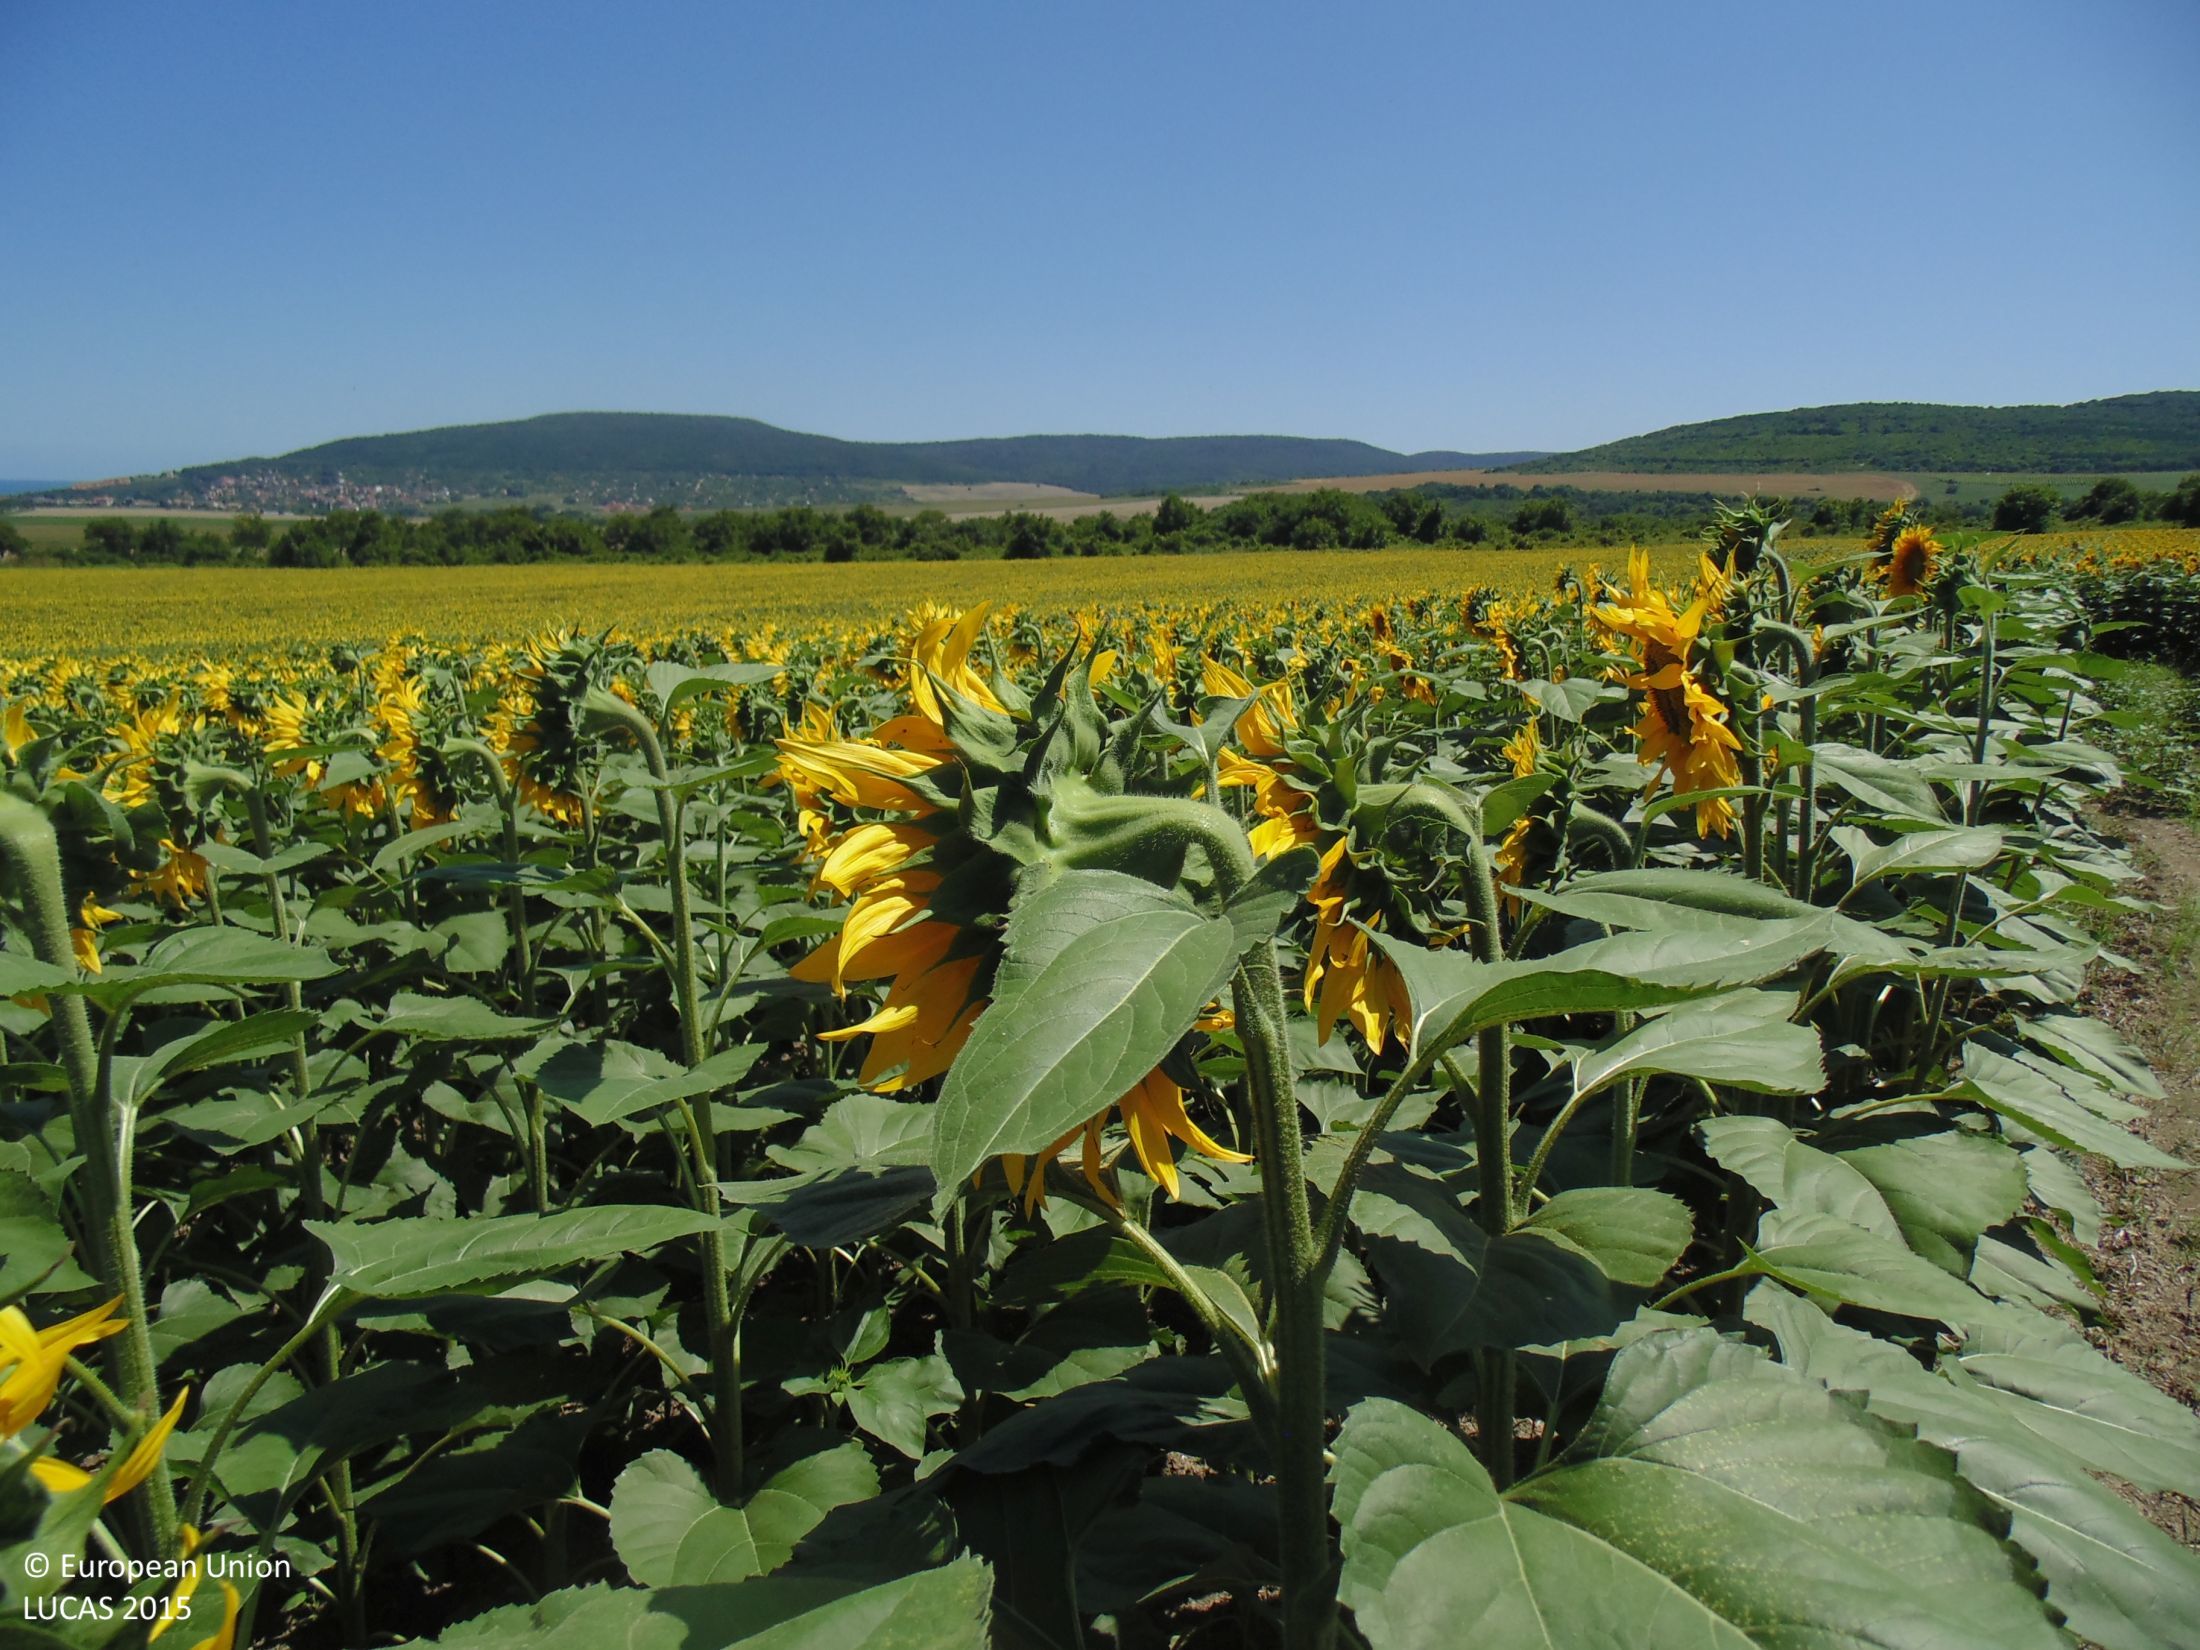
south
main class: Cropland
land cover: Sunflower
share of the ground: > 75 %
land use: Agriculture (excluding fallow land and kitchen gardens)
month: July
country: BG
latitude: 43.3647
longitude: 28.0252
